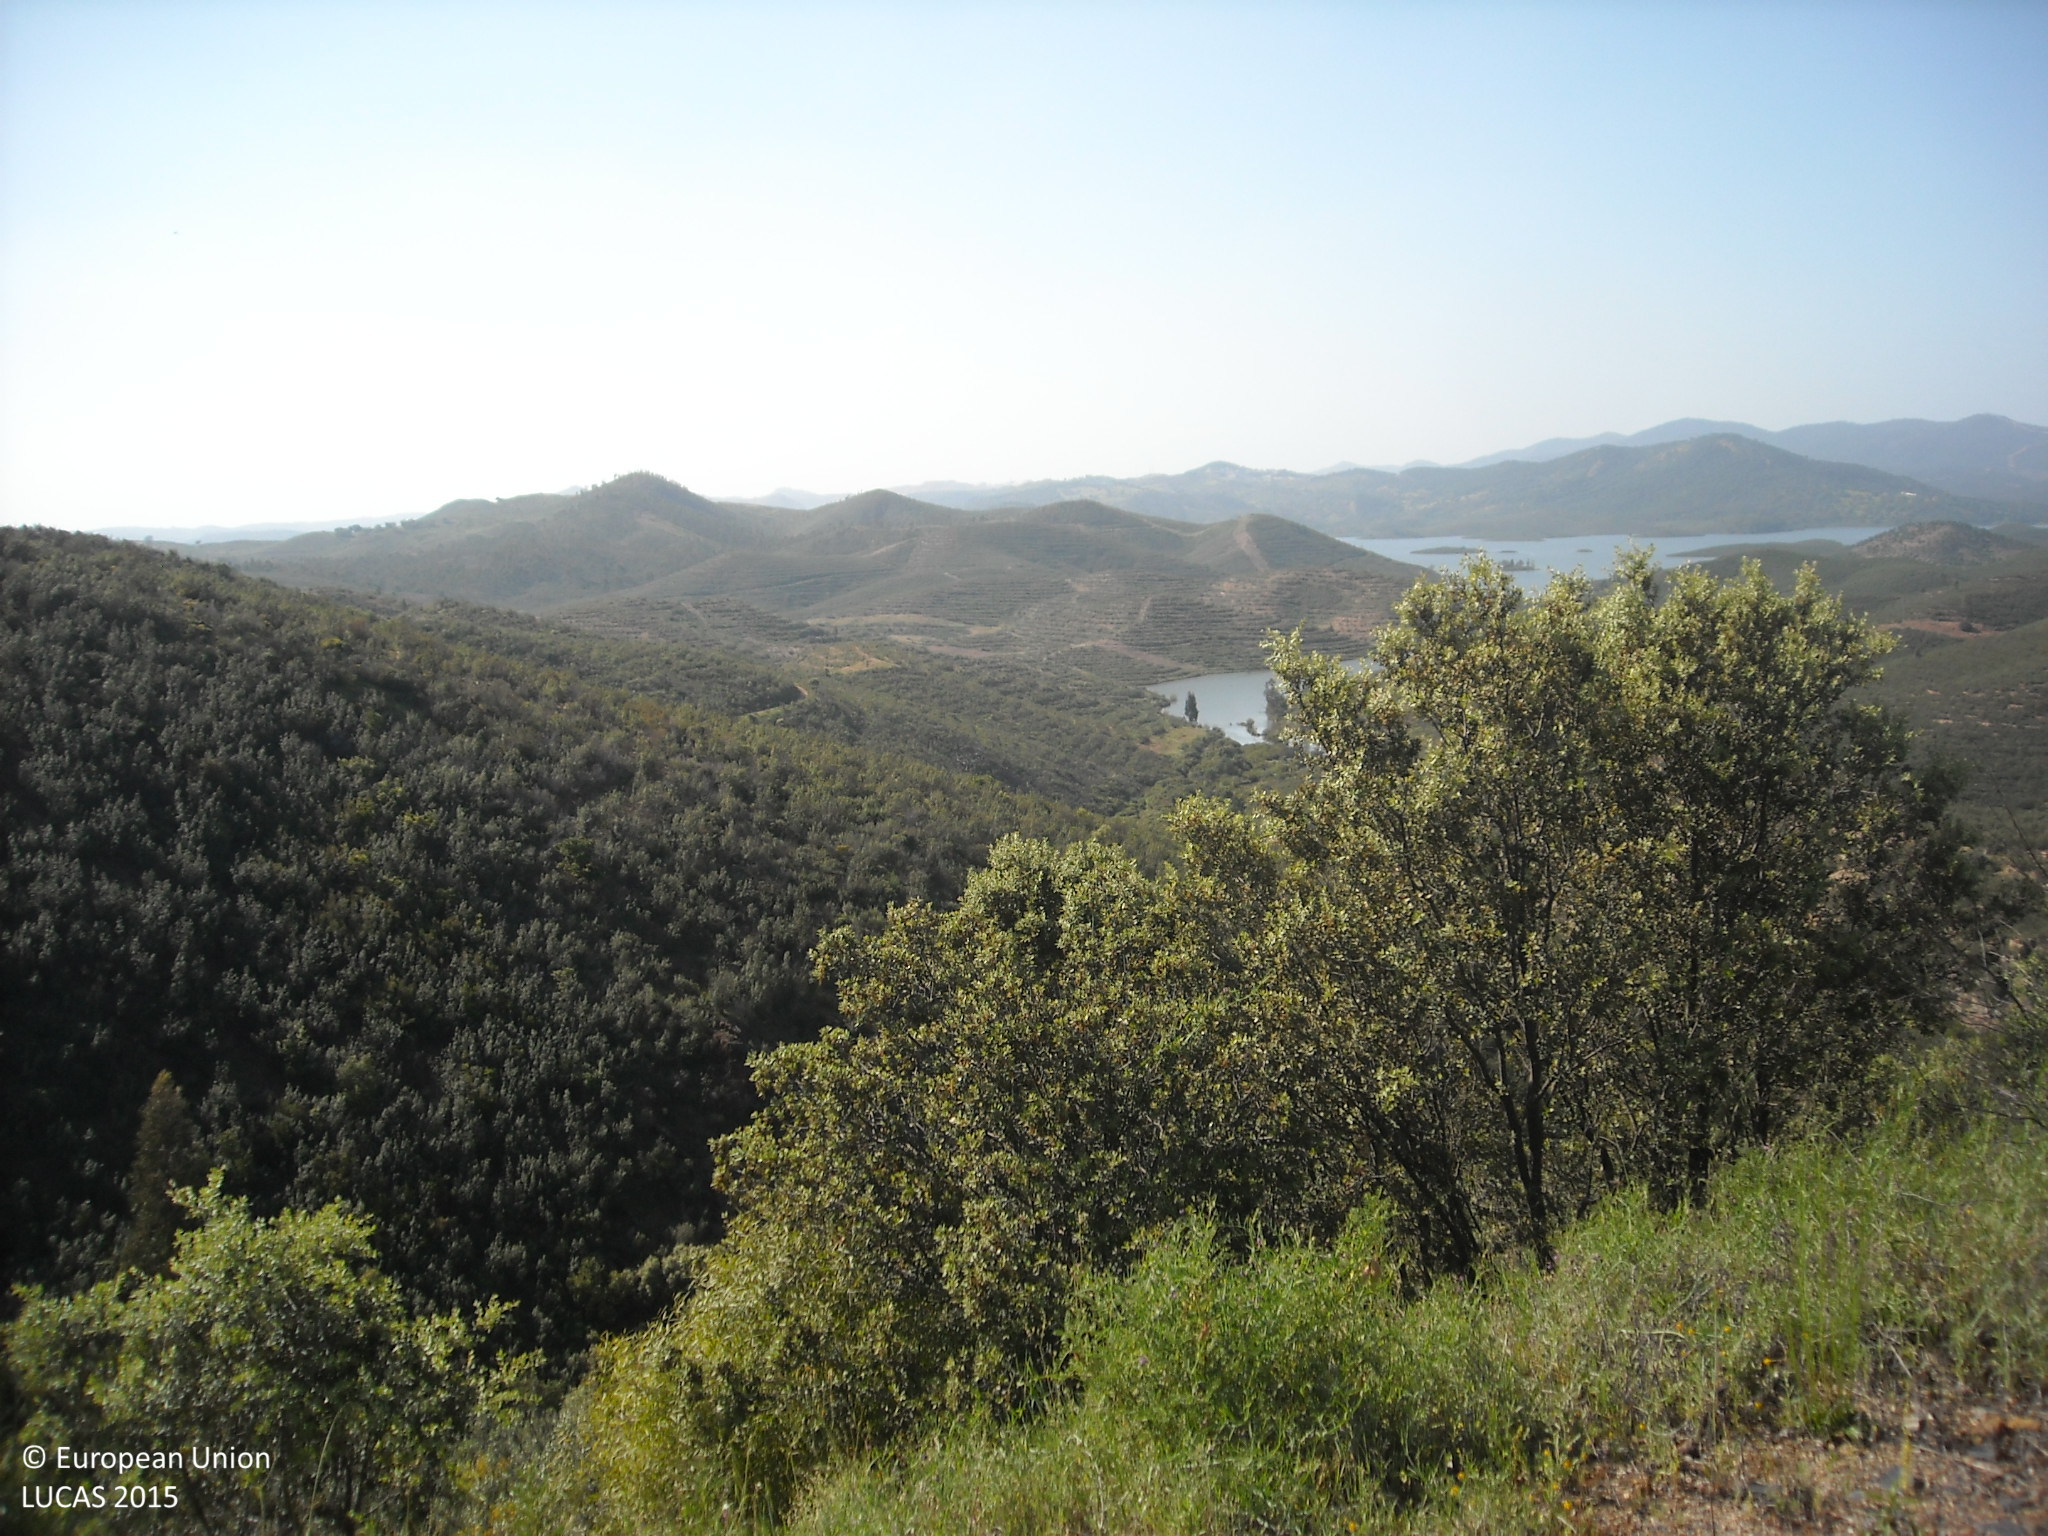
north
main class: Shrubland
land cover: Shrubland without tree cover
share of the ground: > 75 %
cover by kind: shrubs 75 %, herbaceous plants 25 %
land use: Semi-natural and natural areas not in use
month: April
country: ES
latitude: 37.6458
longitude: -6.4822
